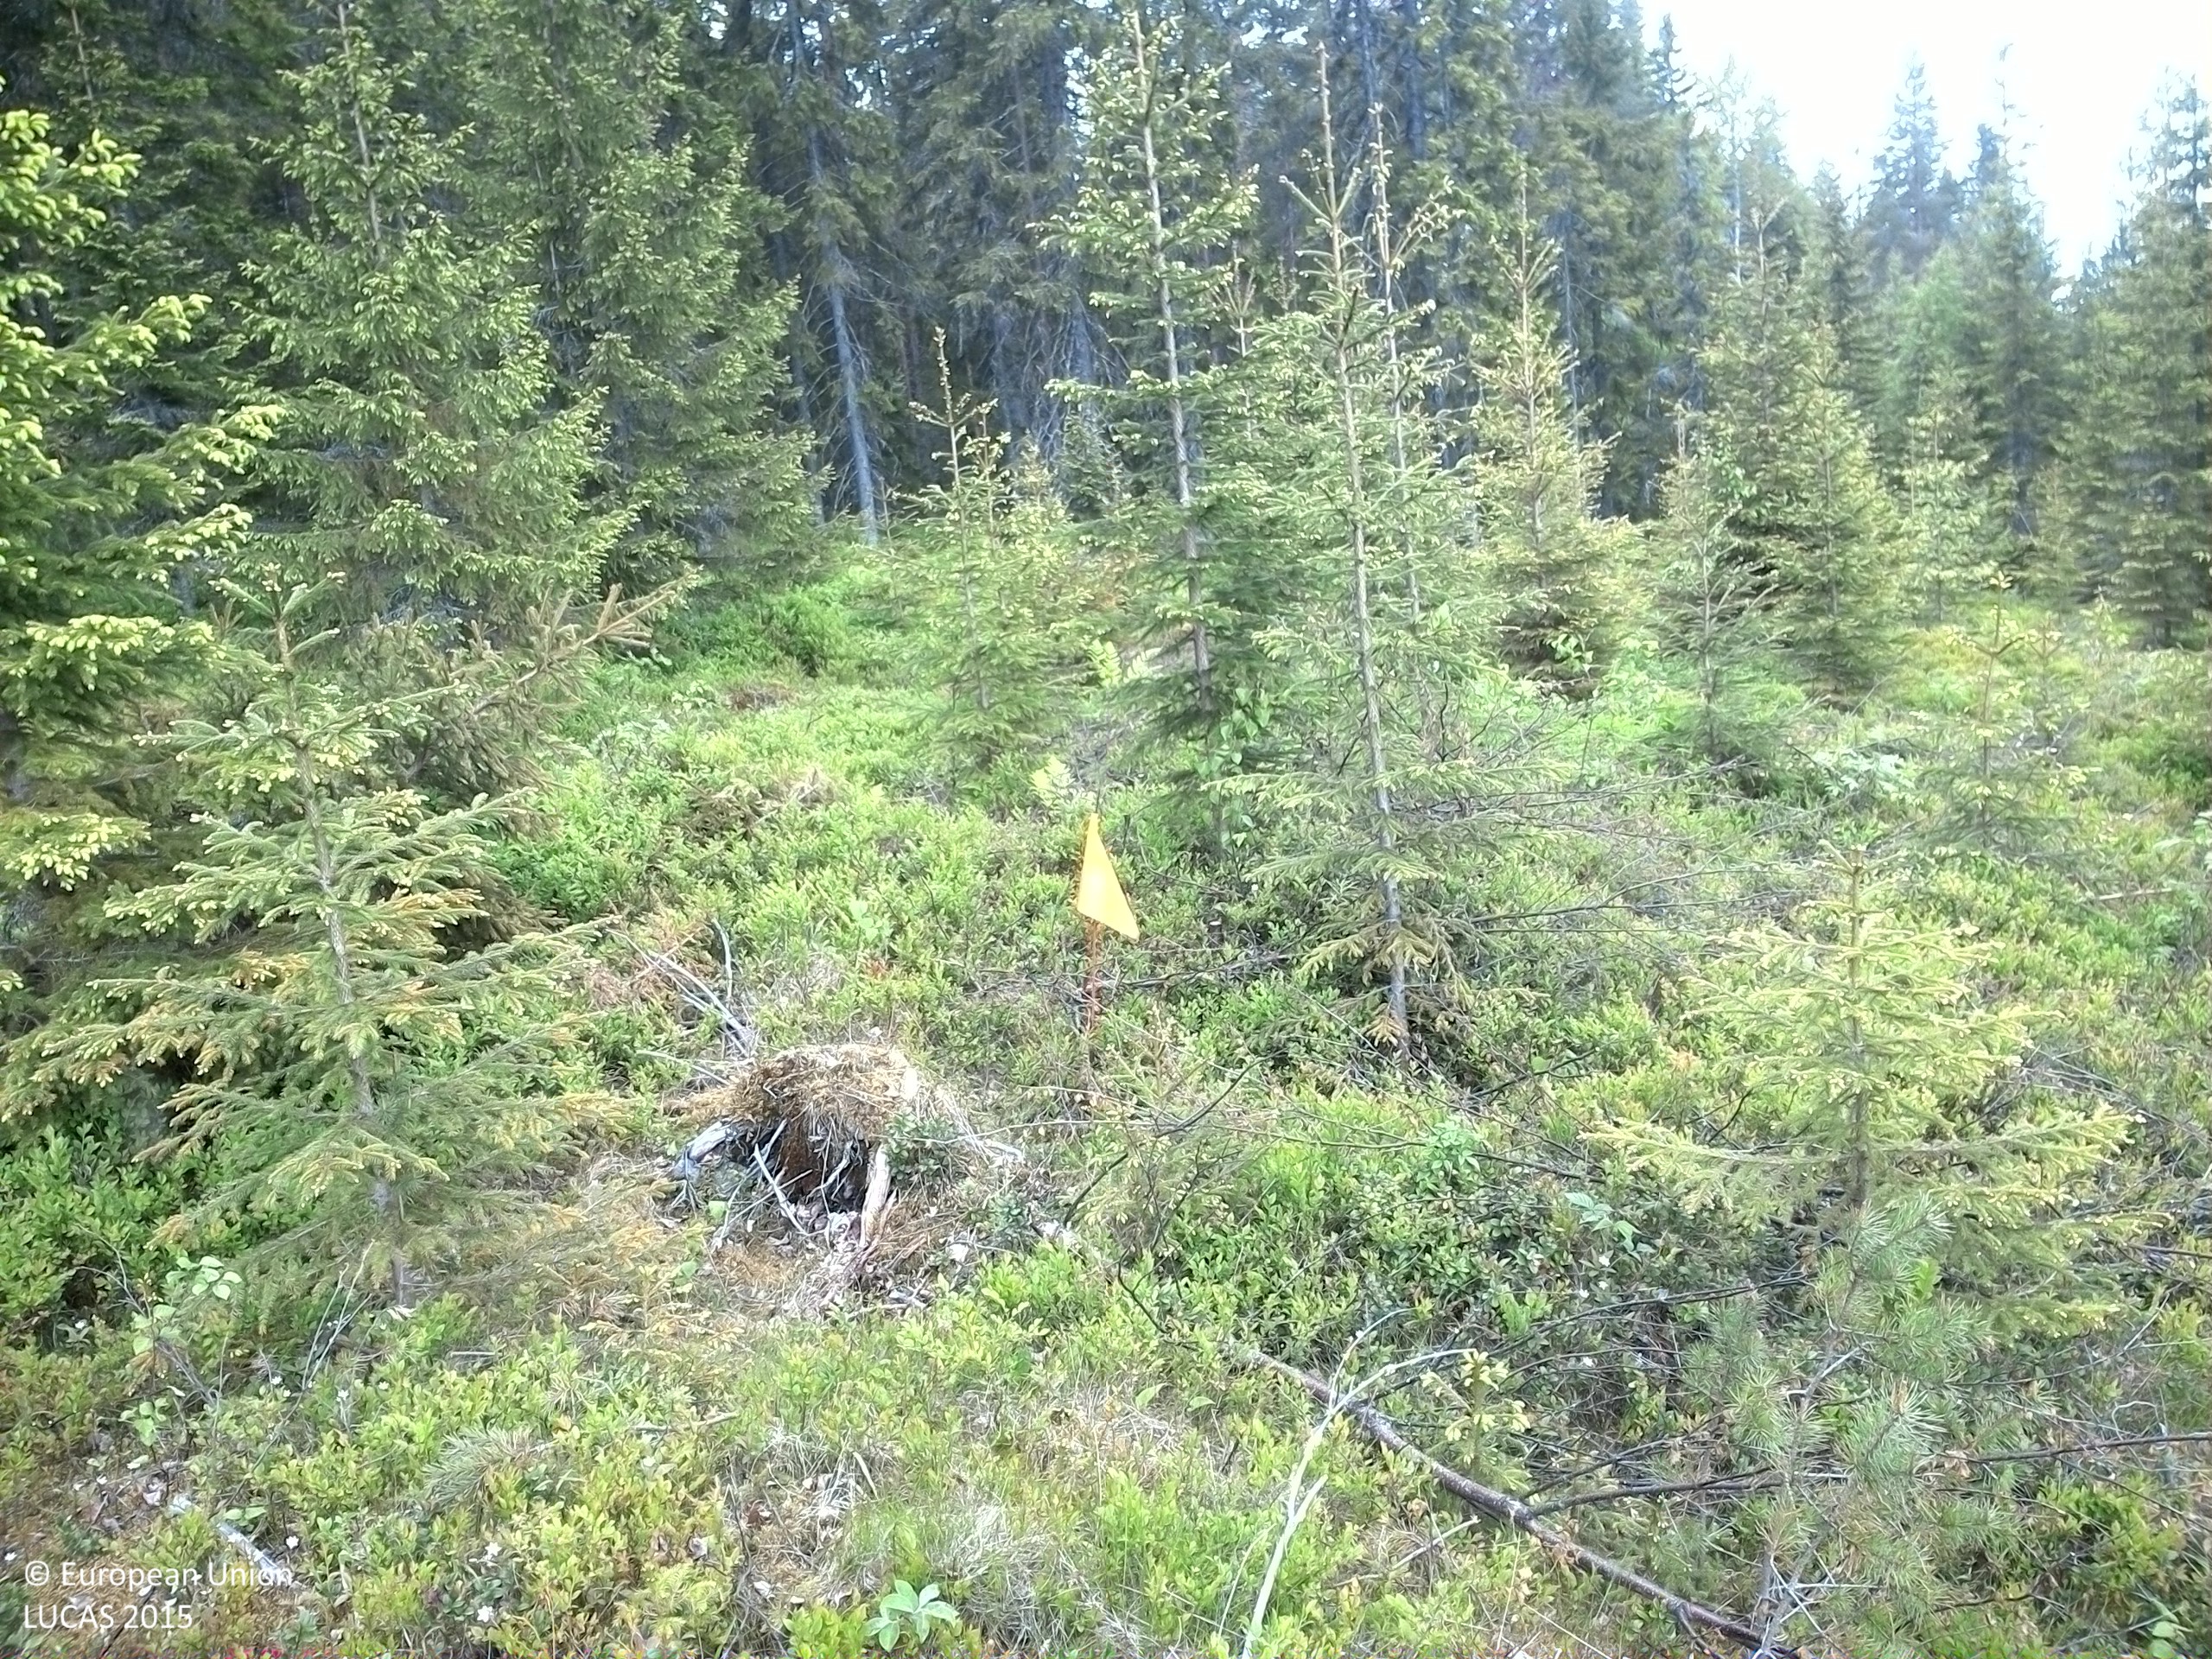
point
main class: Woodland
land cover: Spruce dominated mixed woodland
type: boreal forest
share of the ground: 10 - 25 %
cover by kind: shrubs 70 %, broadleaved forest trees 15 %, herbaceous plants 10 %, coniferous forest trees 5 %
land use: Forestry
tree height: < 5 m
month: June
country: SE
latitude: 63.4268
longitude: 18.1304
